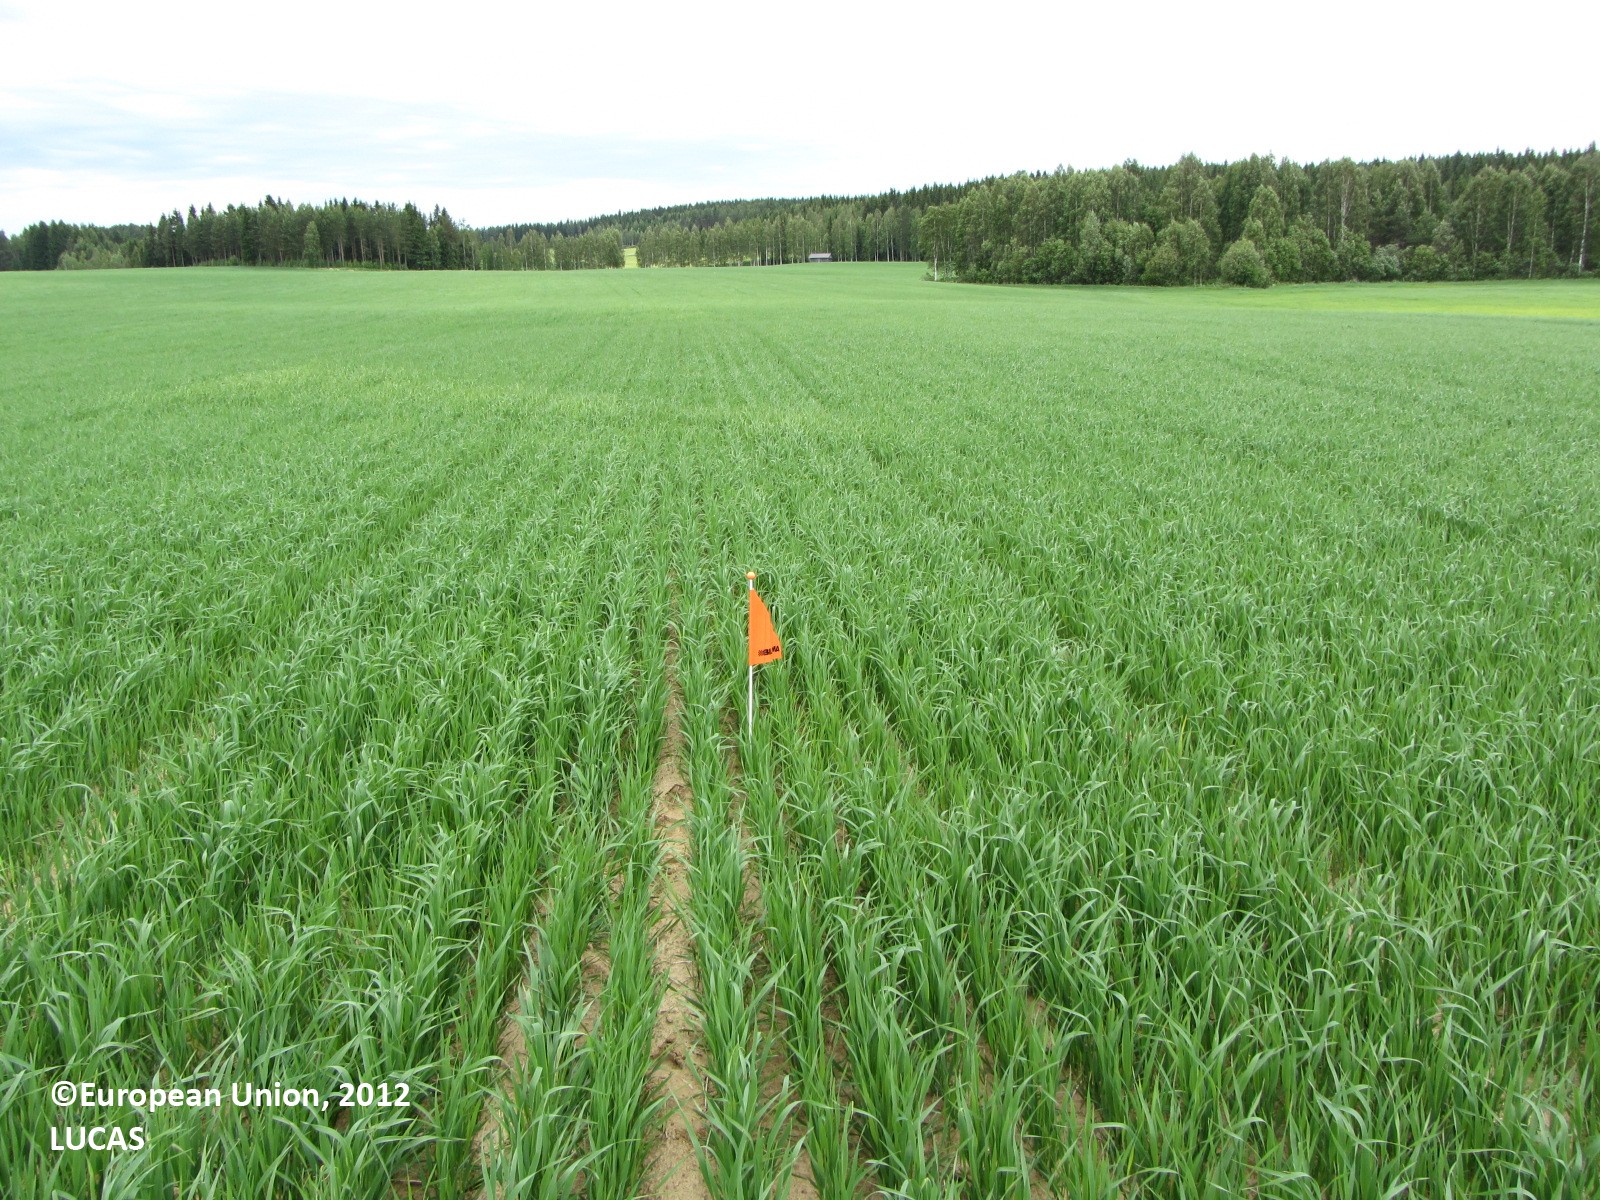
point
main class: Cropland
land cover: Oats
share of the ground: > 75 %
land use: Agriculture (excluding fallow land and kitchen gardens)
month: June
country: FI
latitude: 62.7849
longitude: 25.0933
